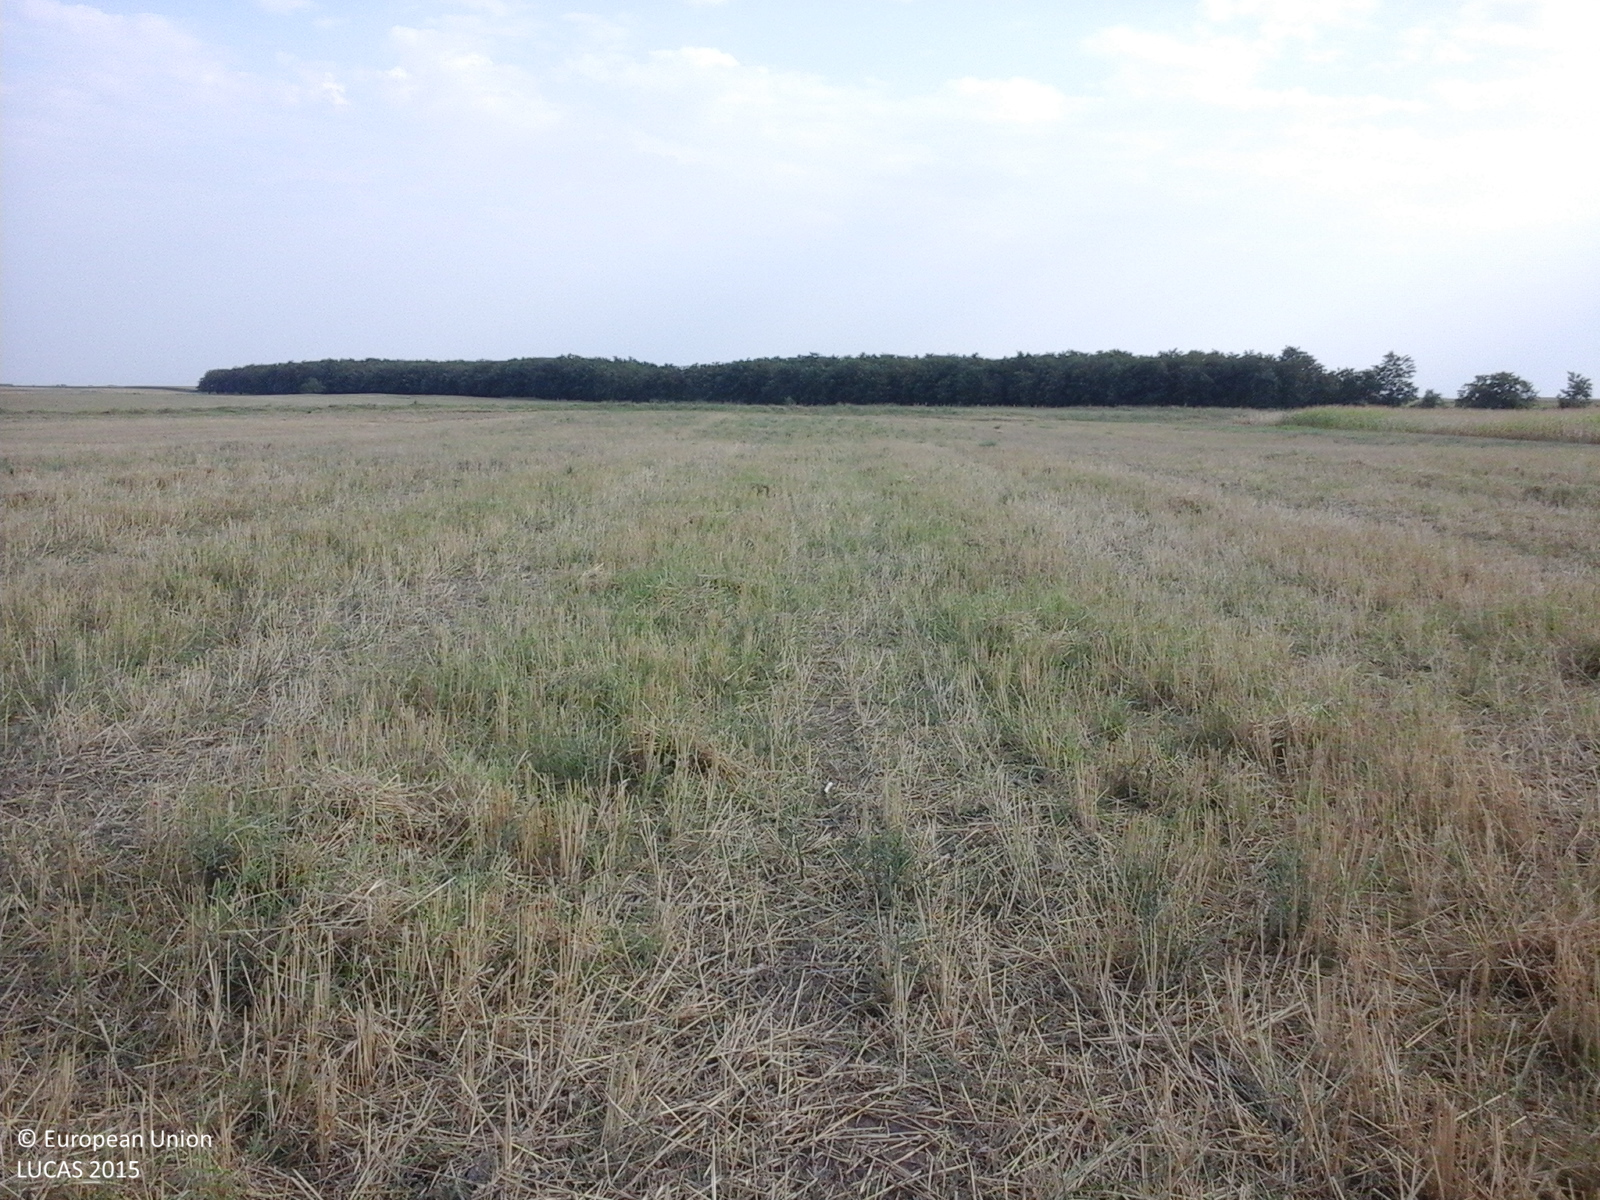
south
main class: Cropland
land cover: Barley
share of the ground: 50 - 75 %
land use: Agriculture (excluding fallow land and kitchen gardens)
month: August
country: RO
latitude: 45.2545
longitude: 27.5458
